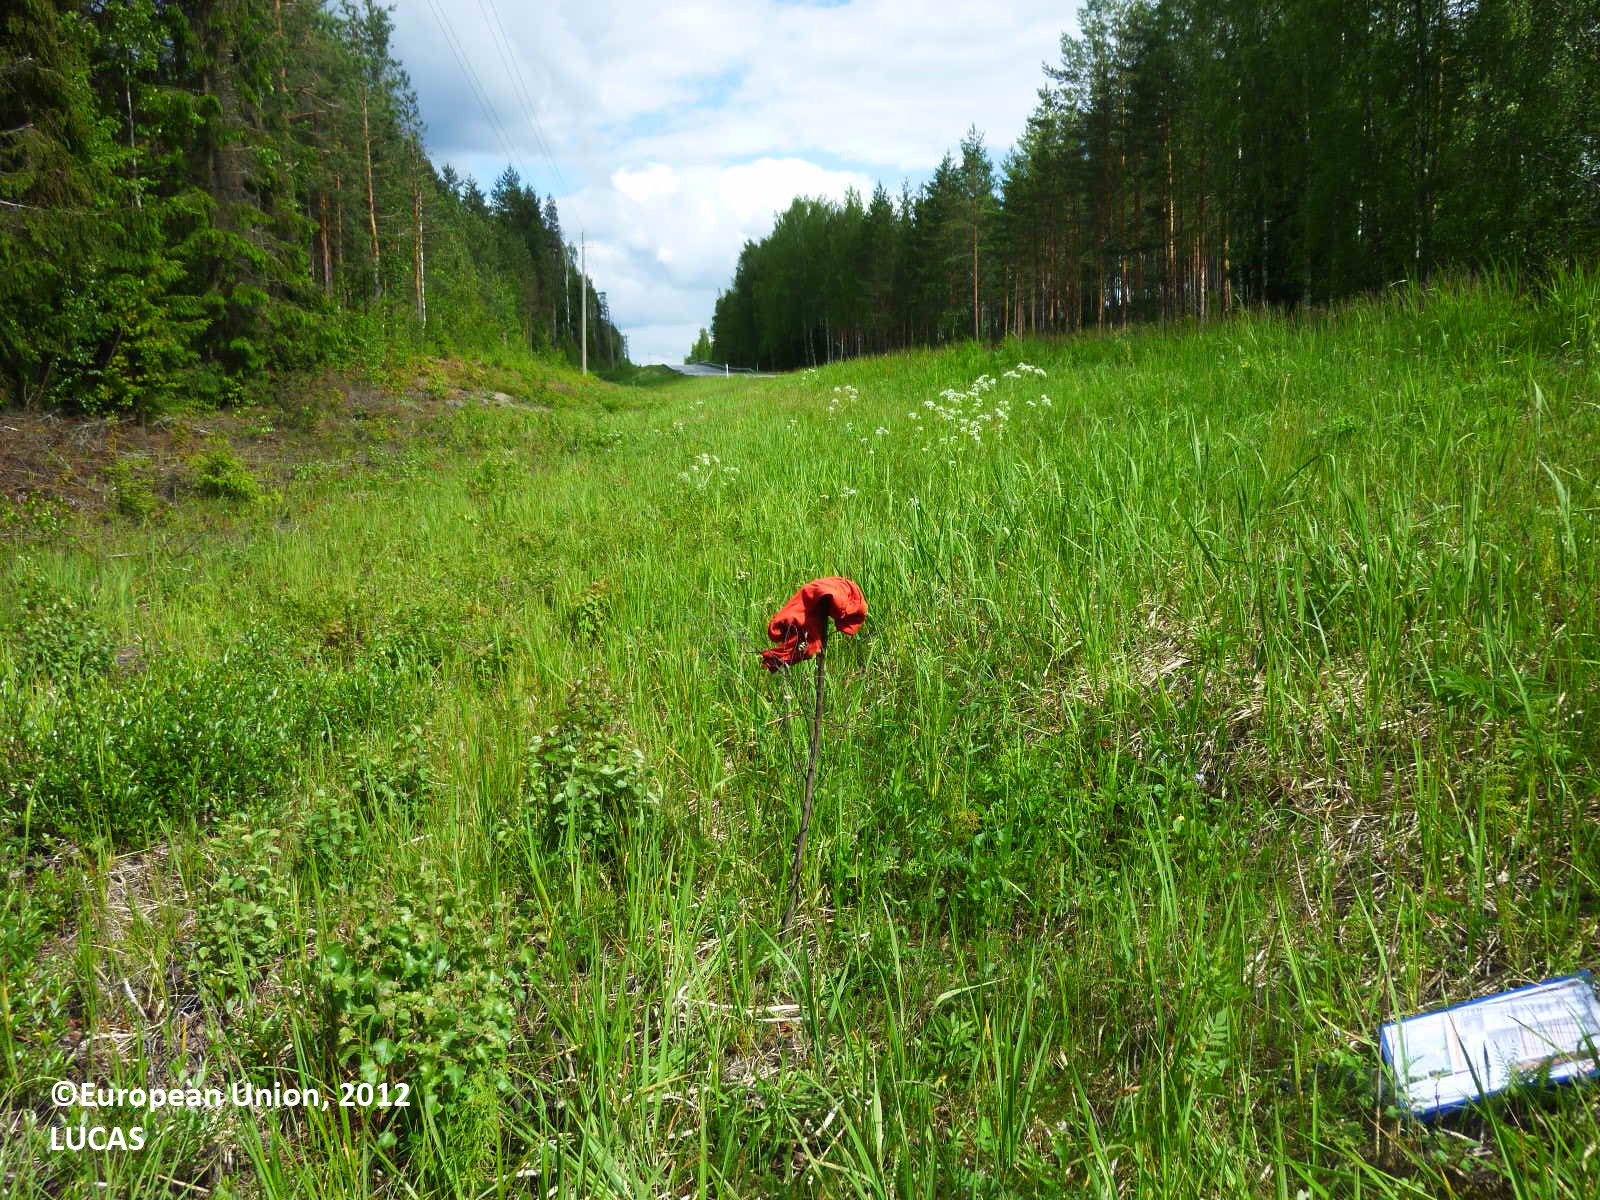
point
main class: Grassland
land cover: Grassland without tree/shrub cover
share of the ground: > 75 %
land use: Road transport
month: June
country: FI
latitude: 61.4780
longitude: 22.5868
